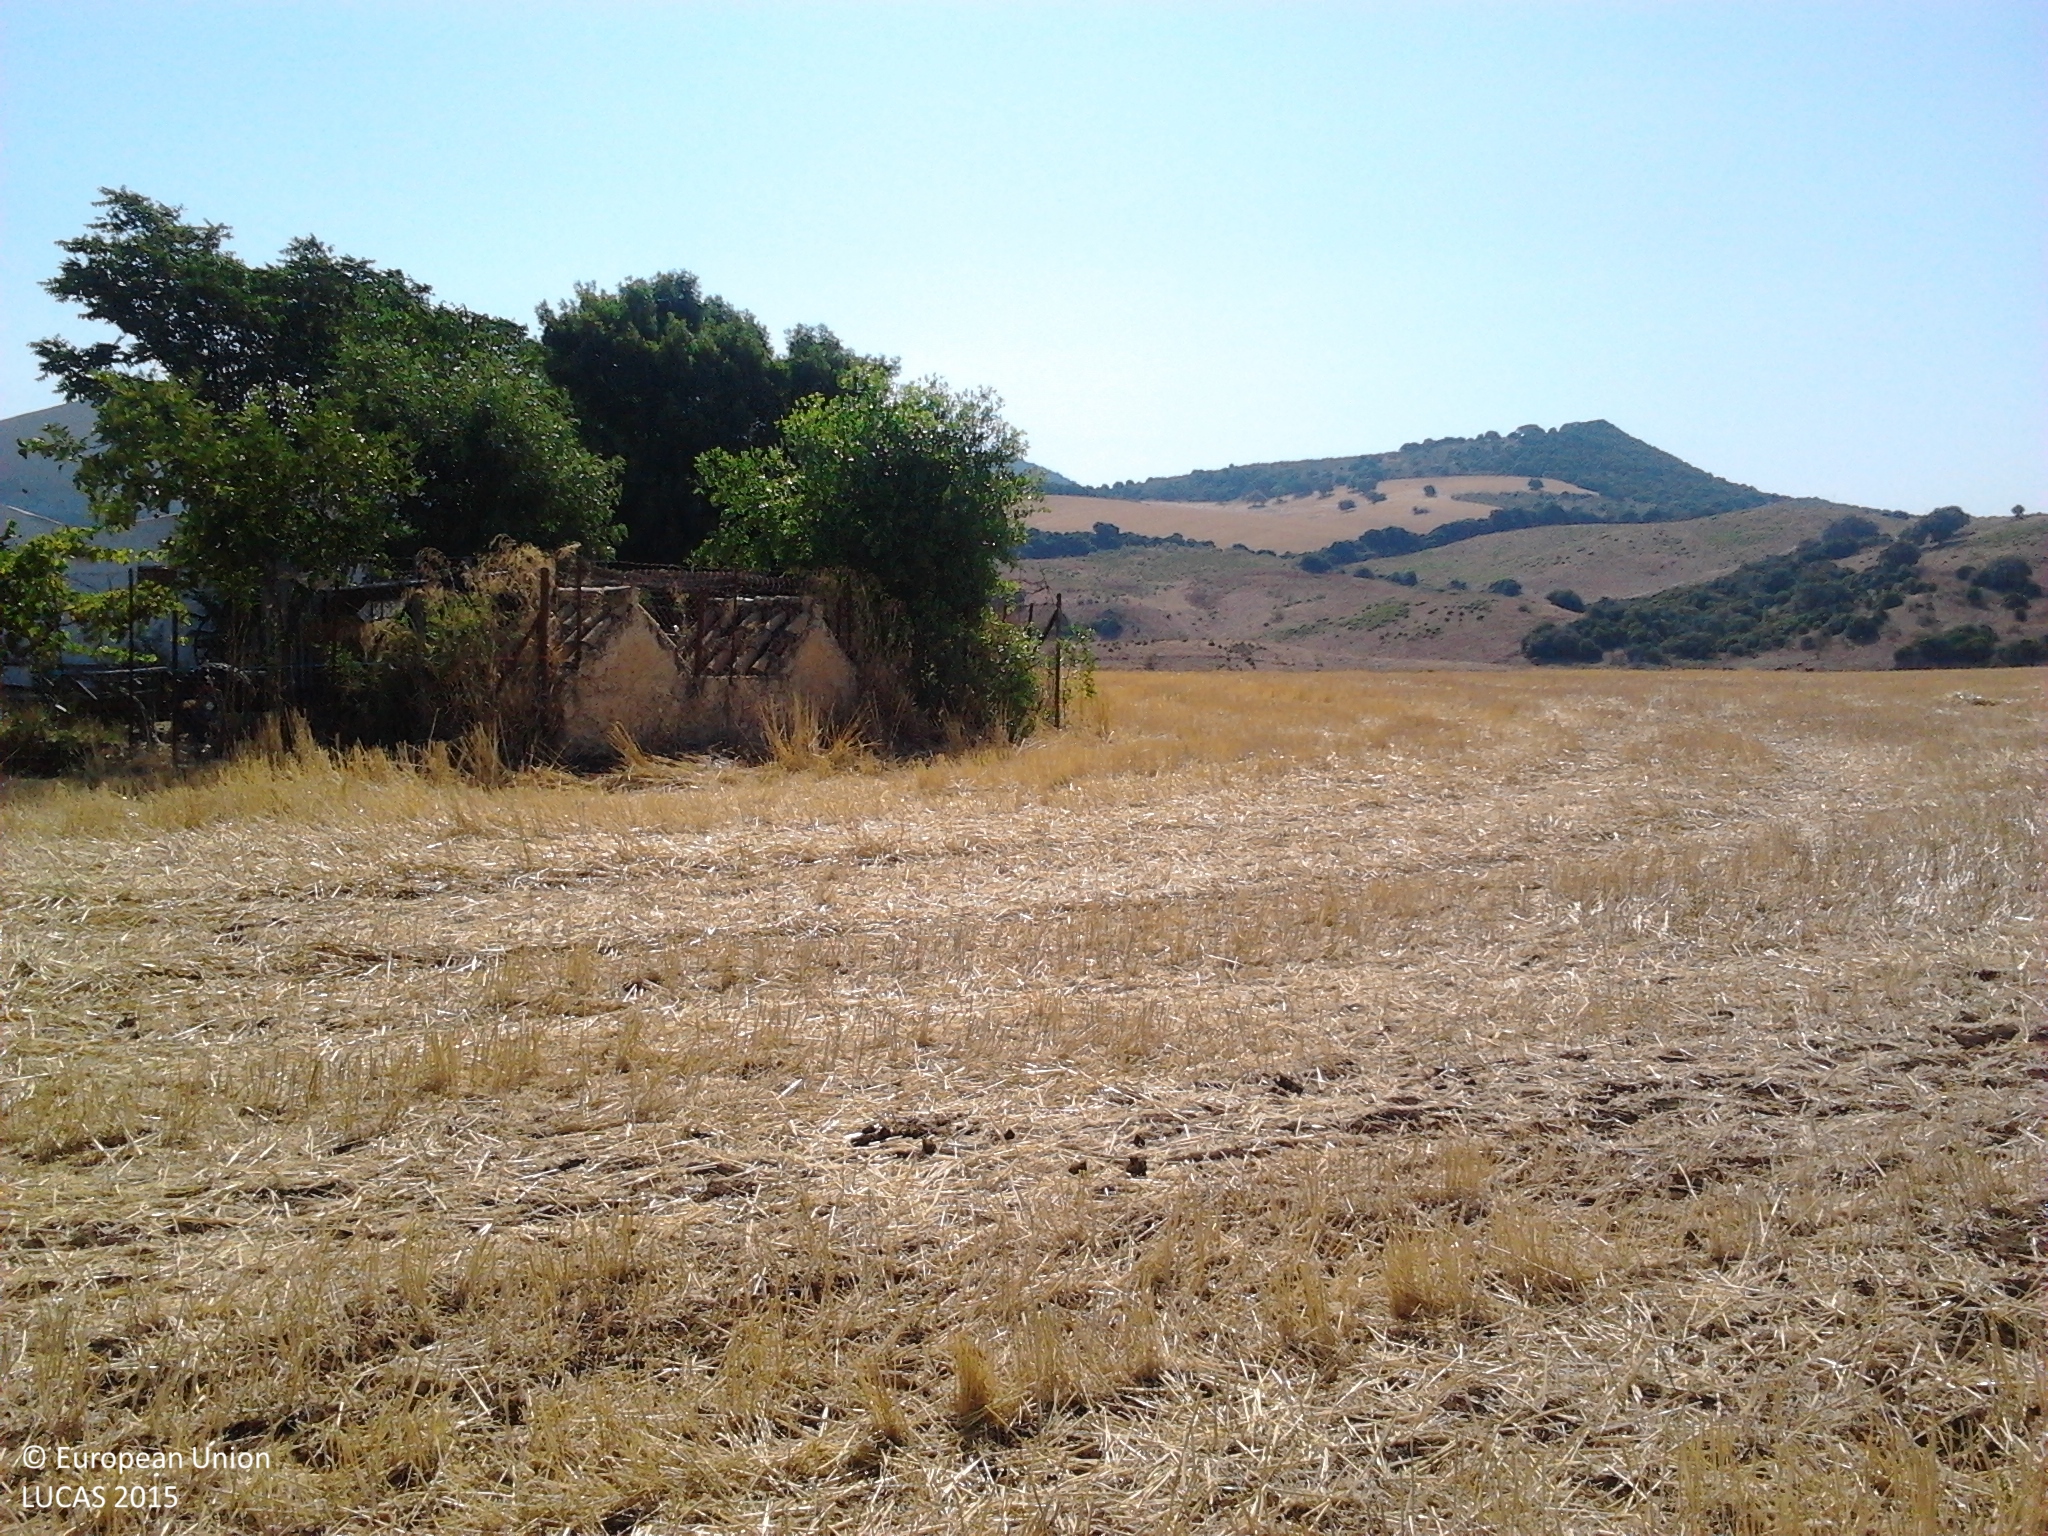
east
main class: Cropland
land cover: Common wheat
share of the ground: < 10 %
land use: Agriculture (excluding fallow land and kitchen gardens)
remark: Harvested field
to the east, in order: Common wheat; Grass margins; Fences; Artificial constructions in urban areas; Fences; Common wheat; Grass margins; Fences; Olive groves; Fences; Grassland without tree/shrub cover; Rivers and streams; Shrubland with sparse tree cover; Fences; Spontaneously vegetated surfaces; Fences; Spontaneously vegetated surfaces
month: July
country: ES
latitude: 36.6773
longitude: -5.6822
